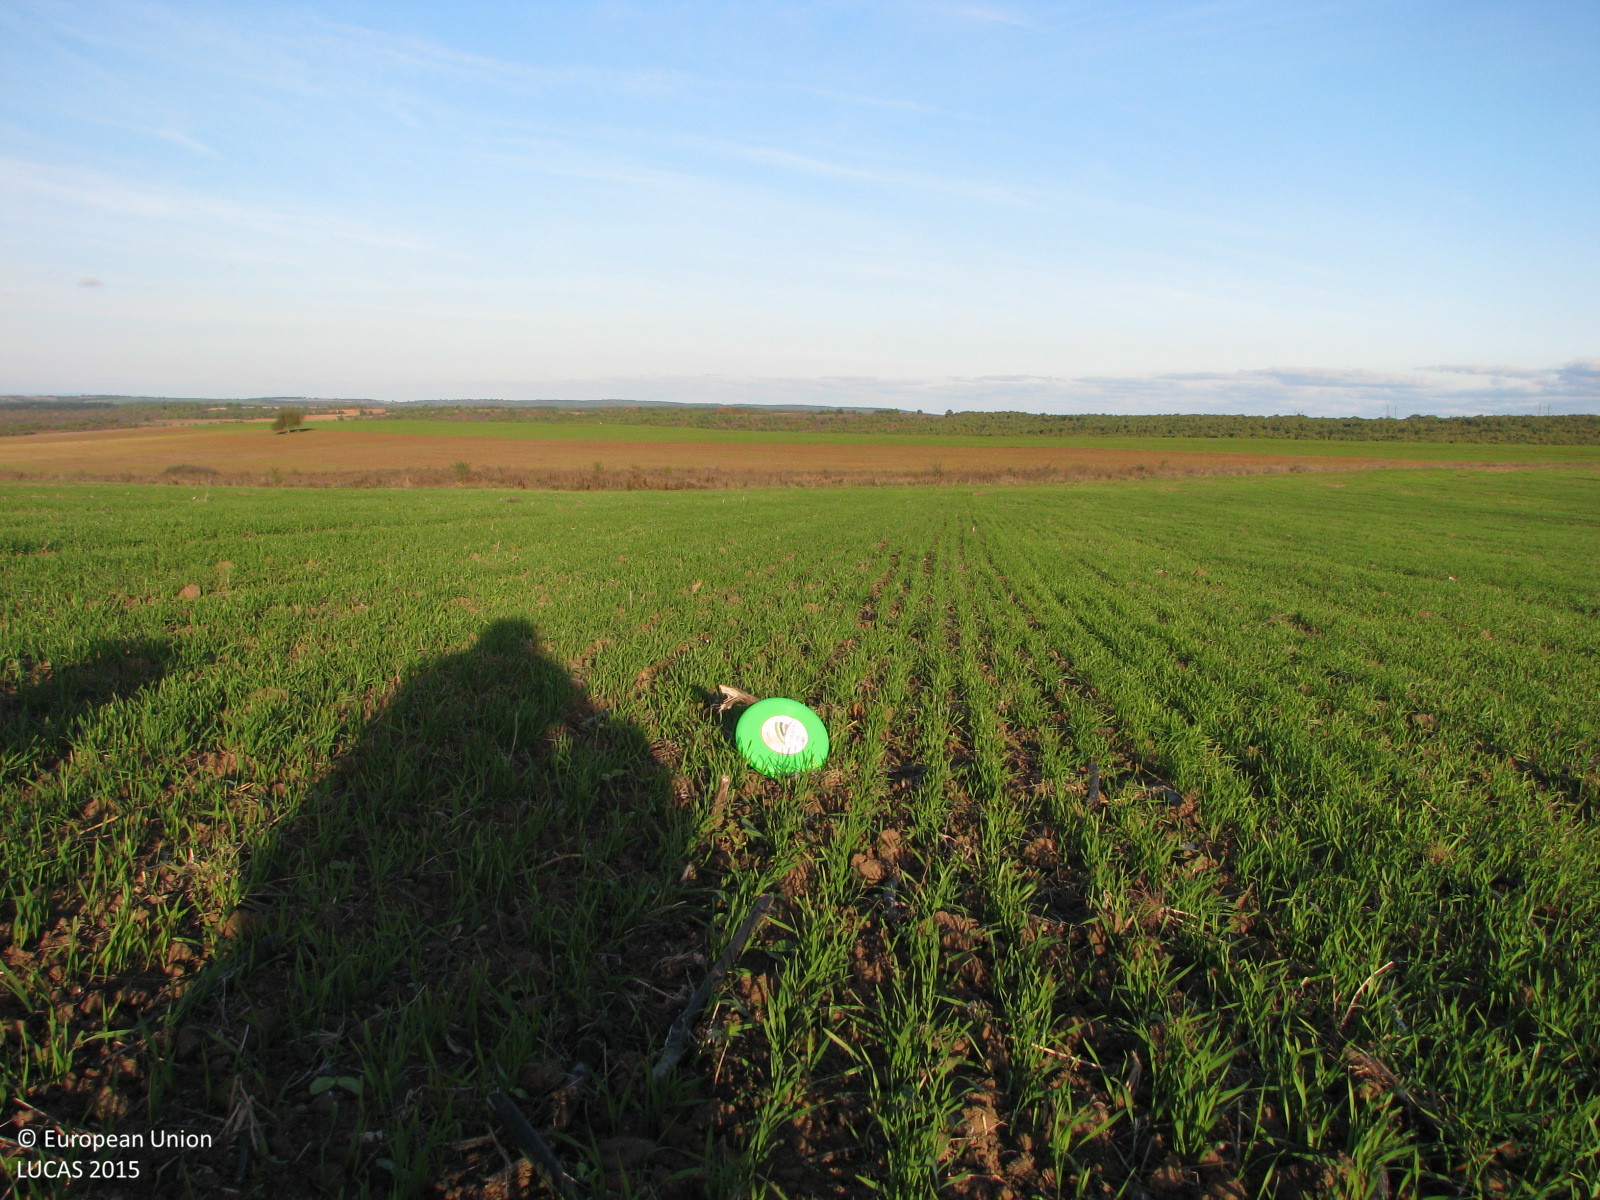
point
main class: Cropland
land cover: Common wheat
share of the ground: > 75 %
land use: Agriculture (excluding fallow land and kitchen gardens)
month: October
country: BG
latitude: 42.2847
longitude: 26.8204
